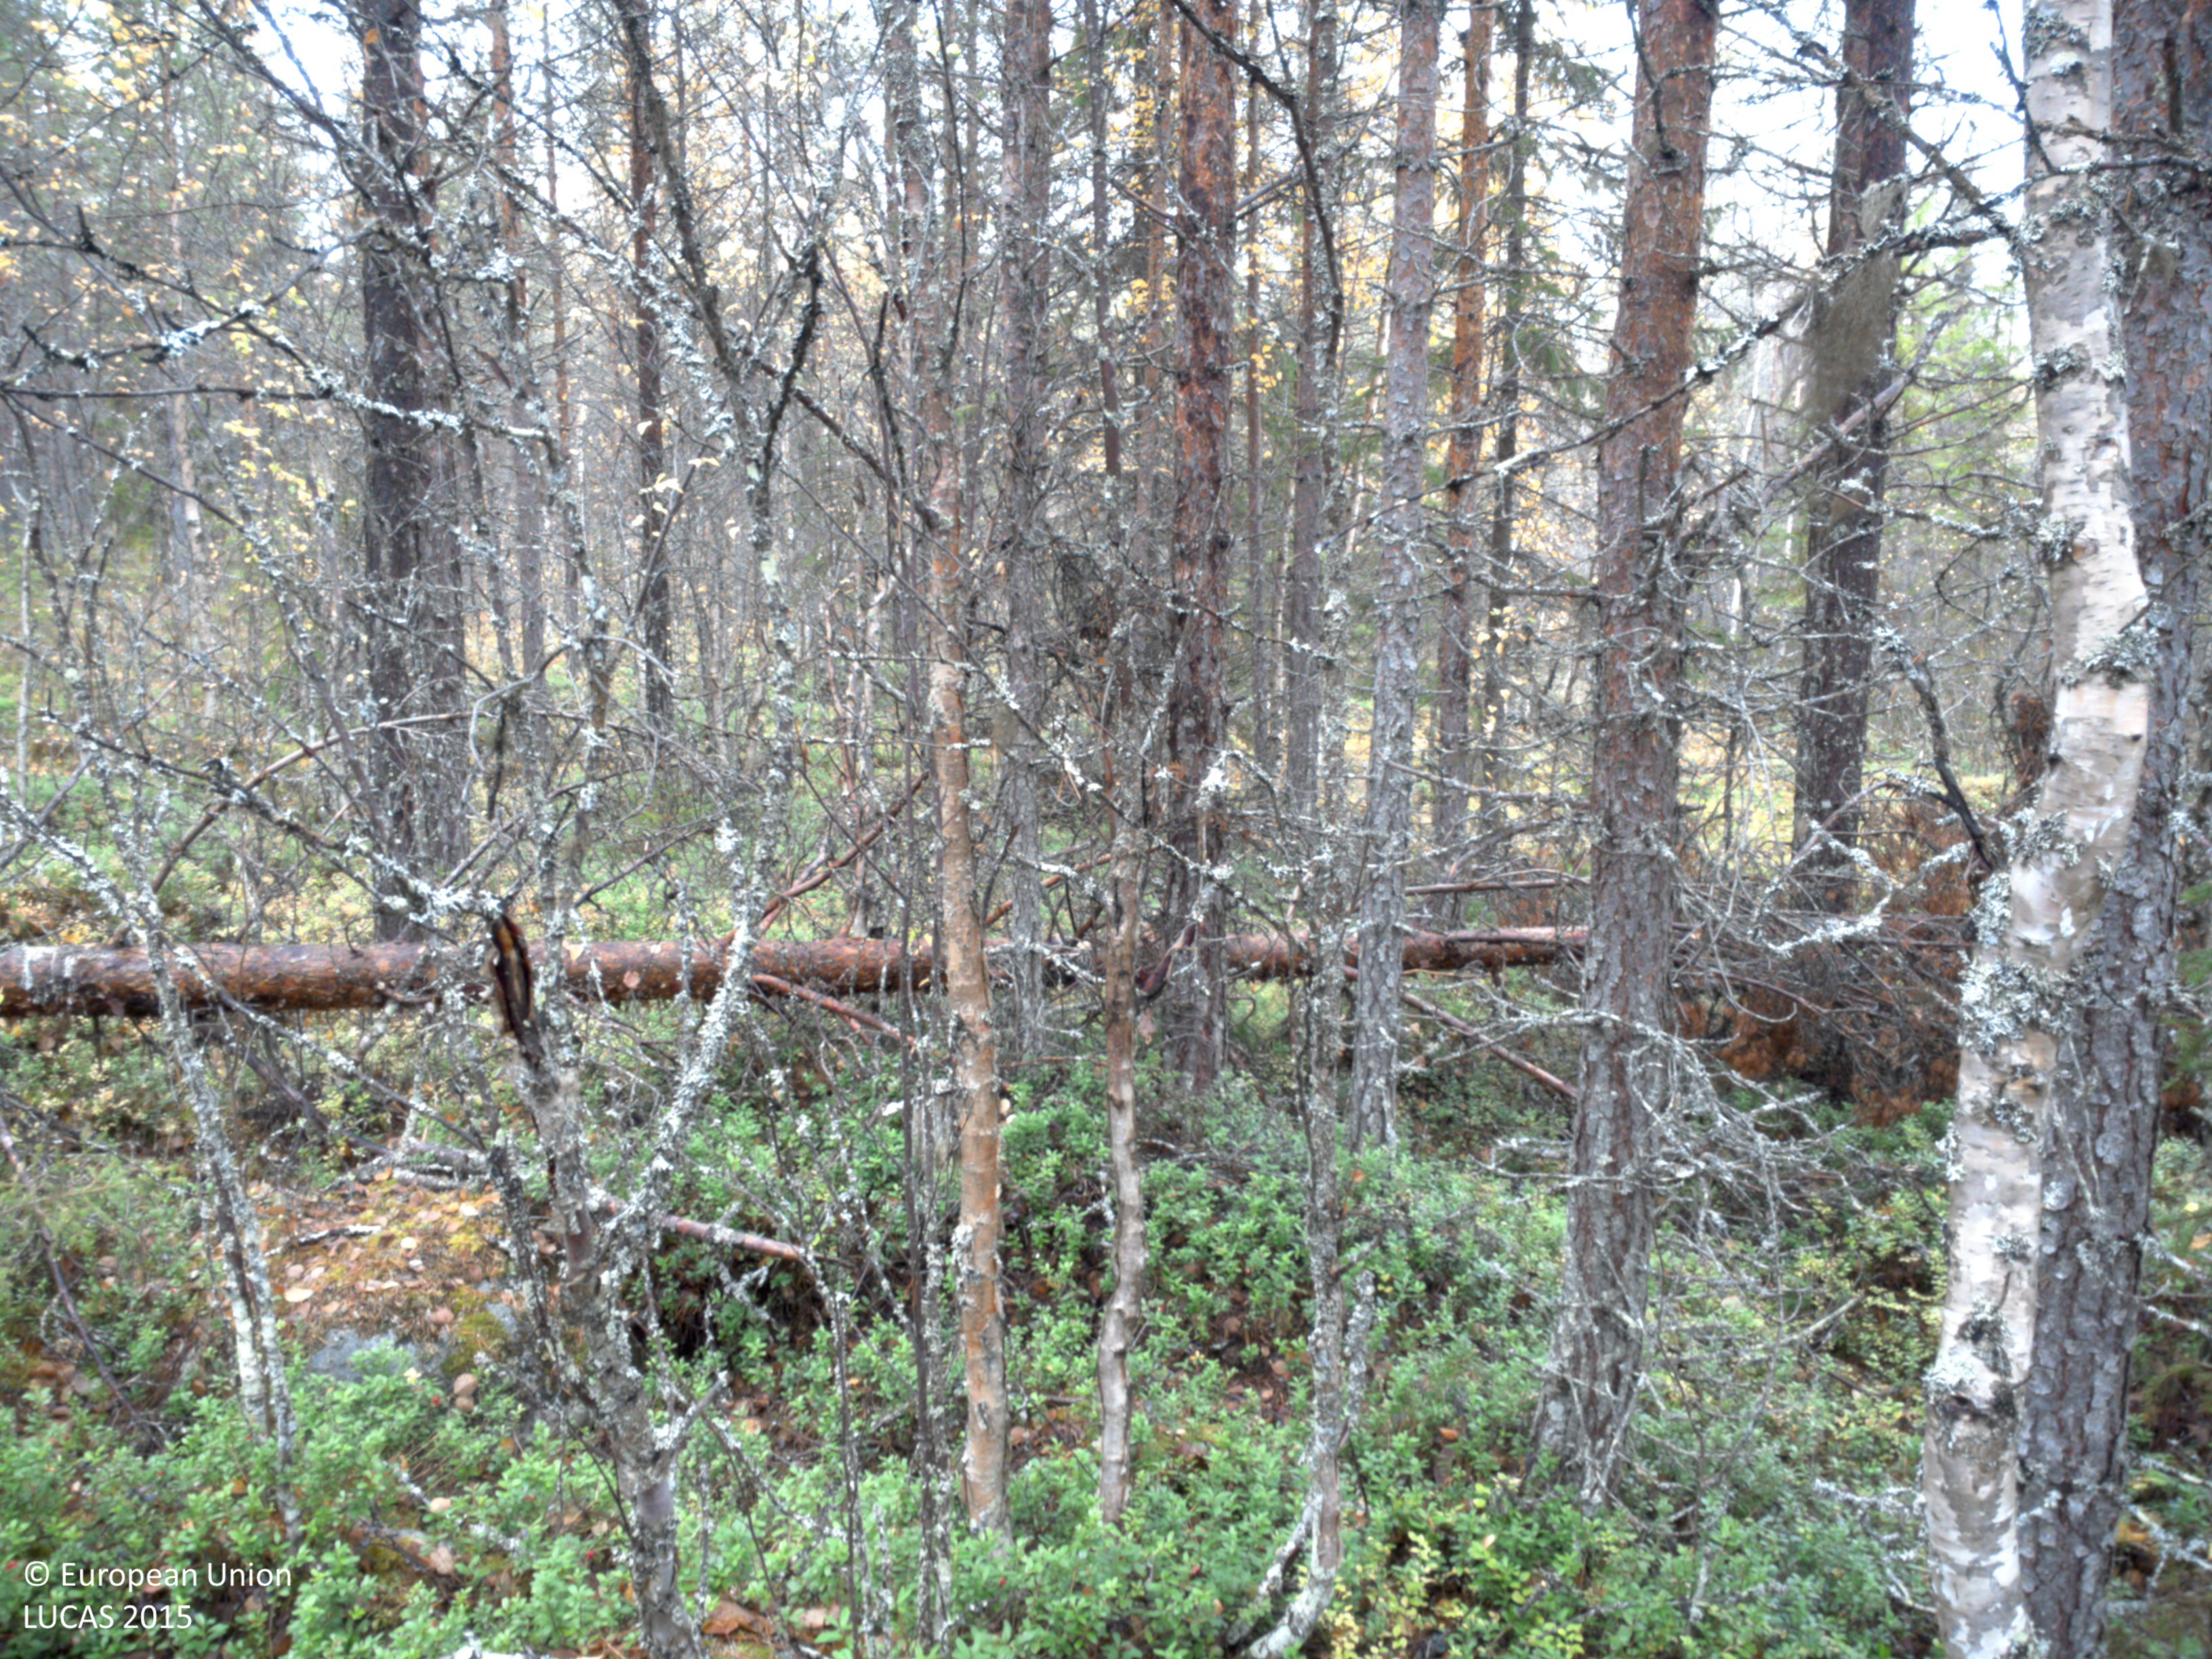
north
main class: Woodland
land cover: Pine dominated coniferous woodland
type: boreal forest
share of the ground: 50 - 75 %
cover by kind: coniferous forest trees 55 %, shrubs 20 %, lichens and mosses 10 %, broadleaved forest trees 5 %, herbaceous plants 5 %, consolidated bare surface 5 %
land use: Forestry
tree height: > 5 m
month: September
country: SE
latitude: 64.9477
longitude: 18.9185
